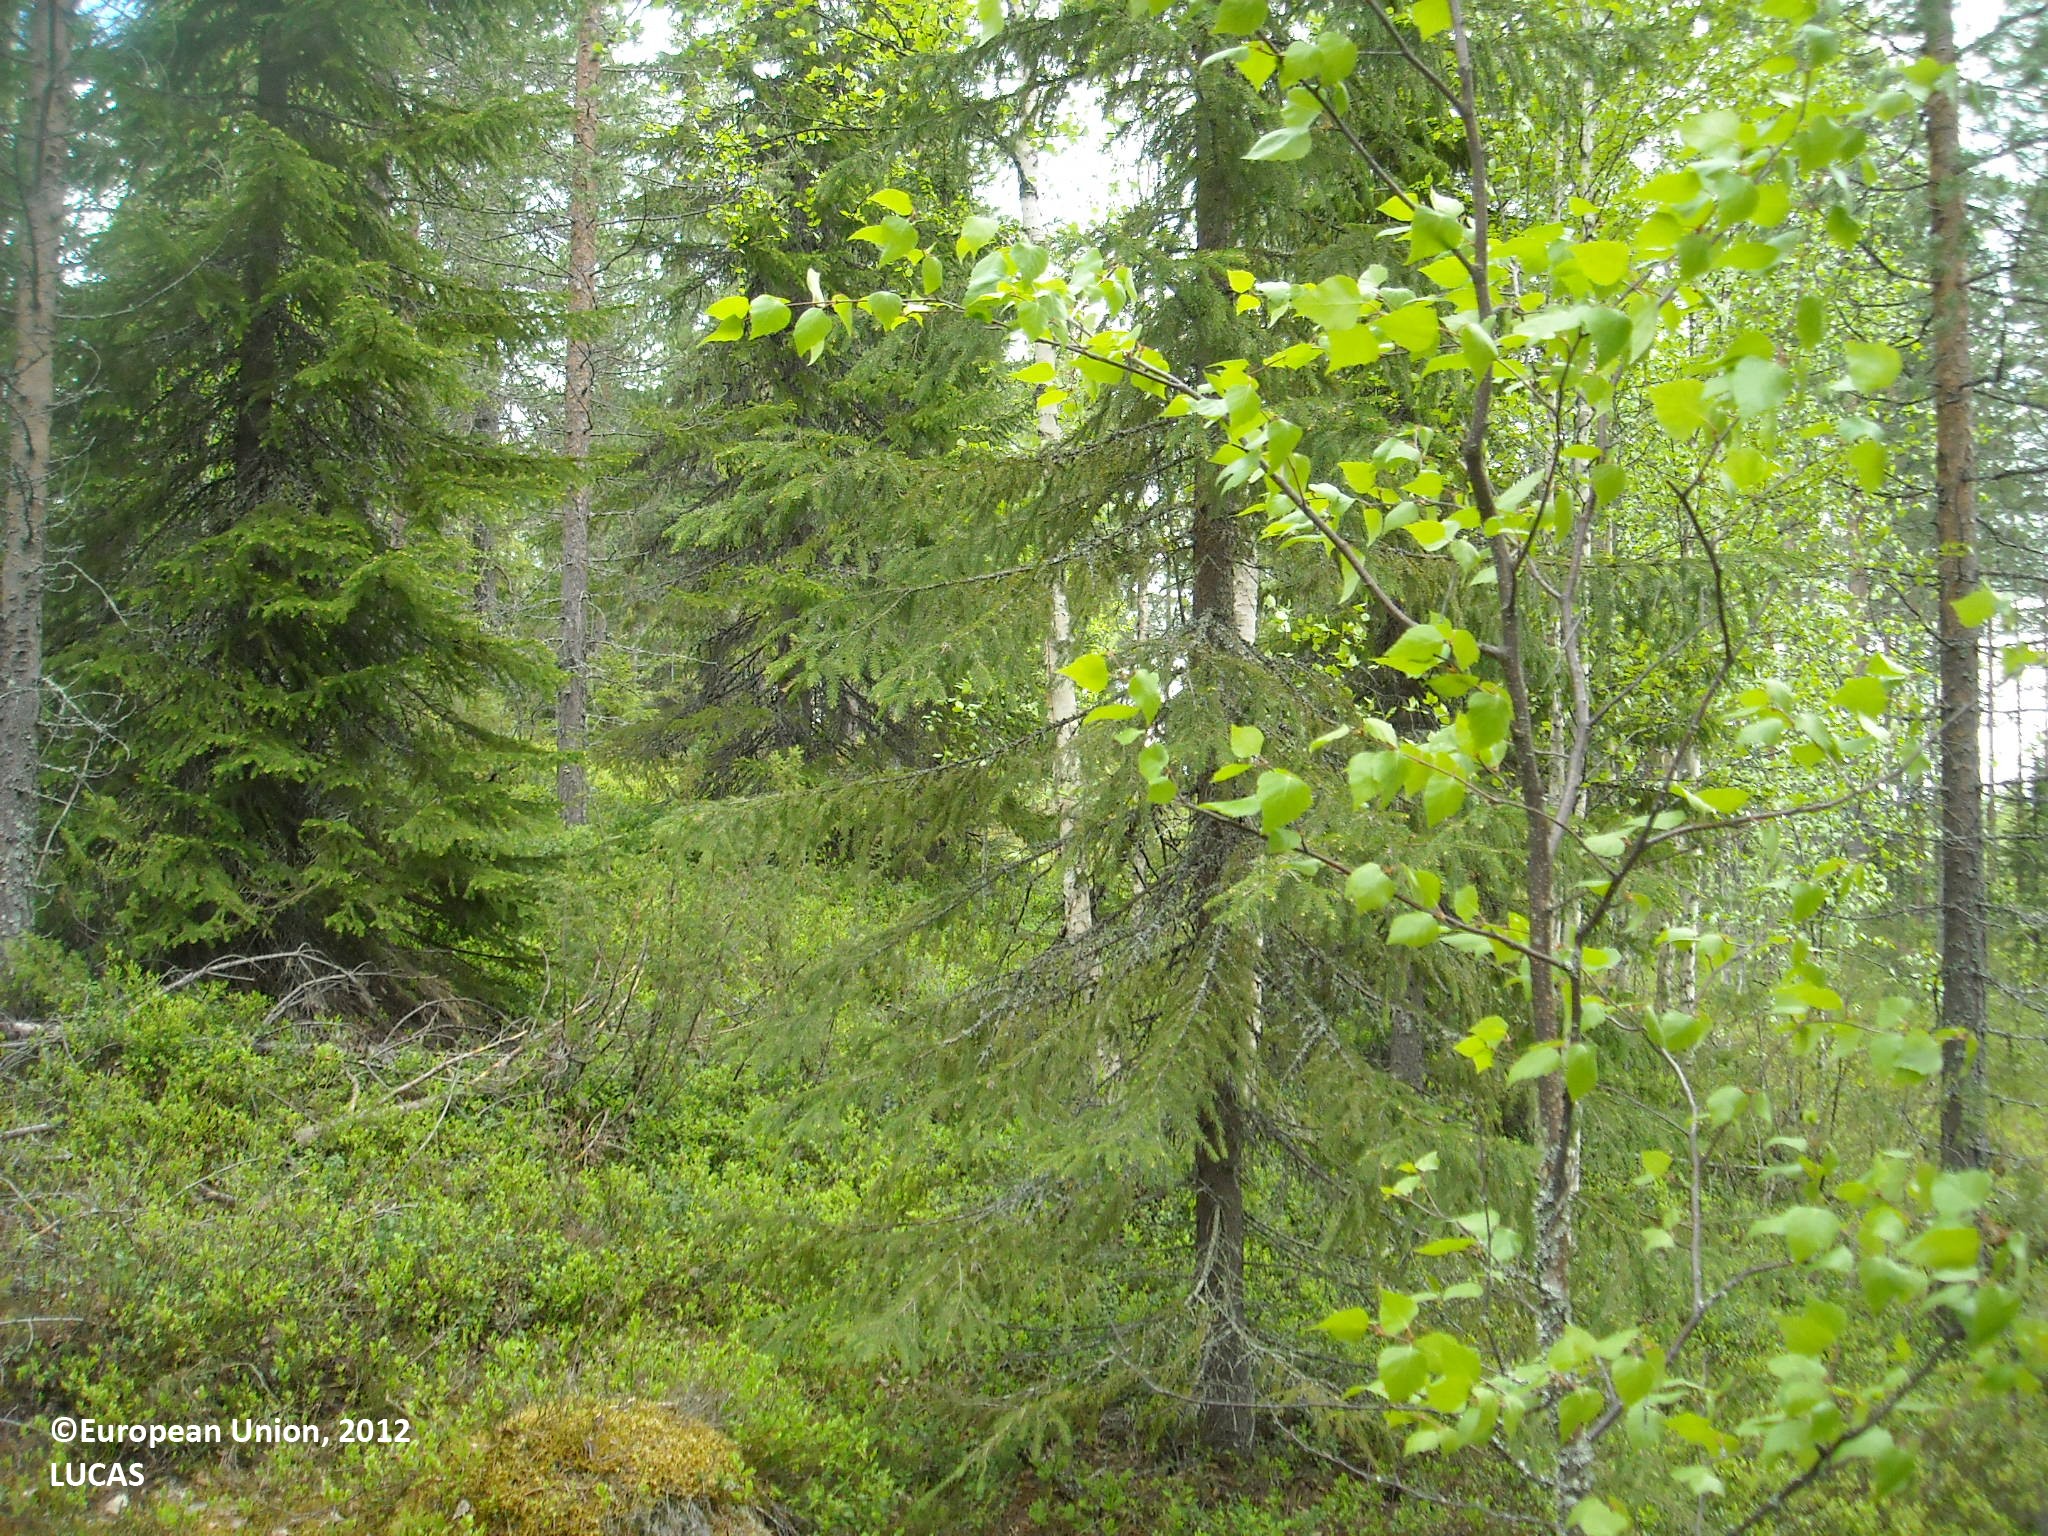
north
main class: Woodland
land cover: Other coniferous woodland
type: boreal forest
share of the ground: 50 - 75 %
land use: Forestry
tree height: > 5 m
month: June
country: FI
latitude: 65.2773
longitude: 27.8213
